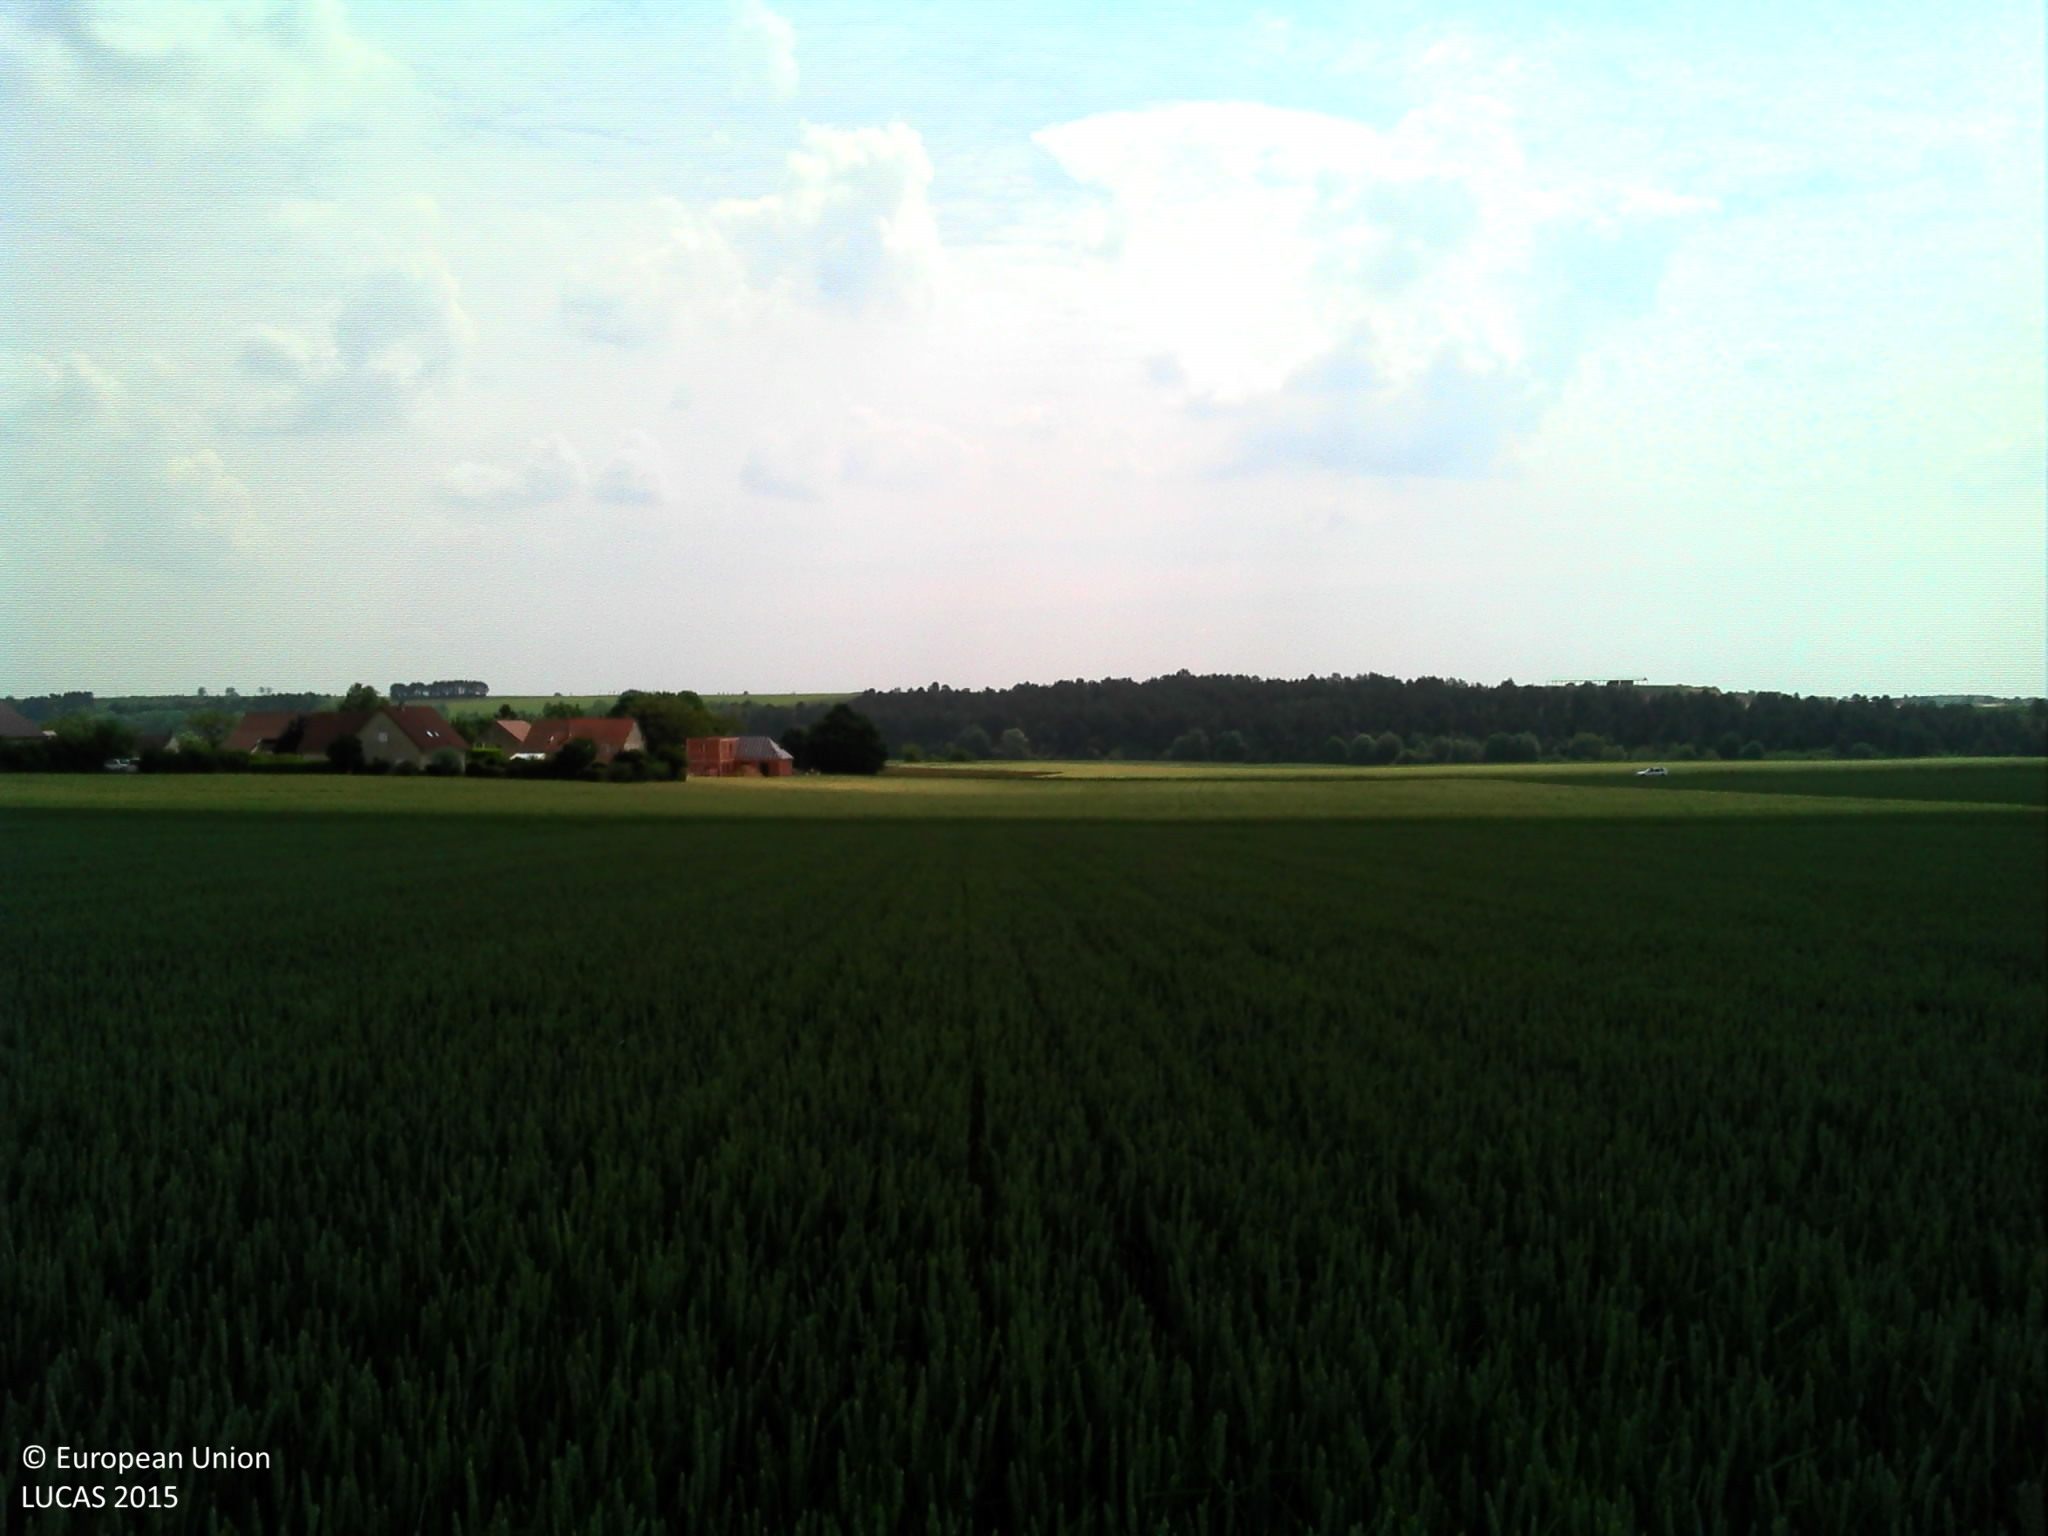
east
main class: Cropland
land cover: Common wheat
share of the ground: > 75 %
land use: Agriculture (excluding fallow land and kitchen gardens)
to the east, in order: Common wheat; Barley
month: May
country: FR
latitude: 47.4454
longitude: 5.0537
